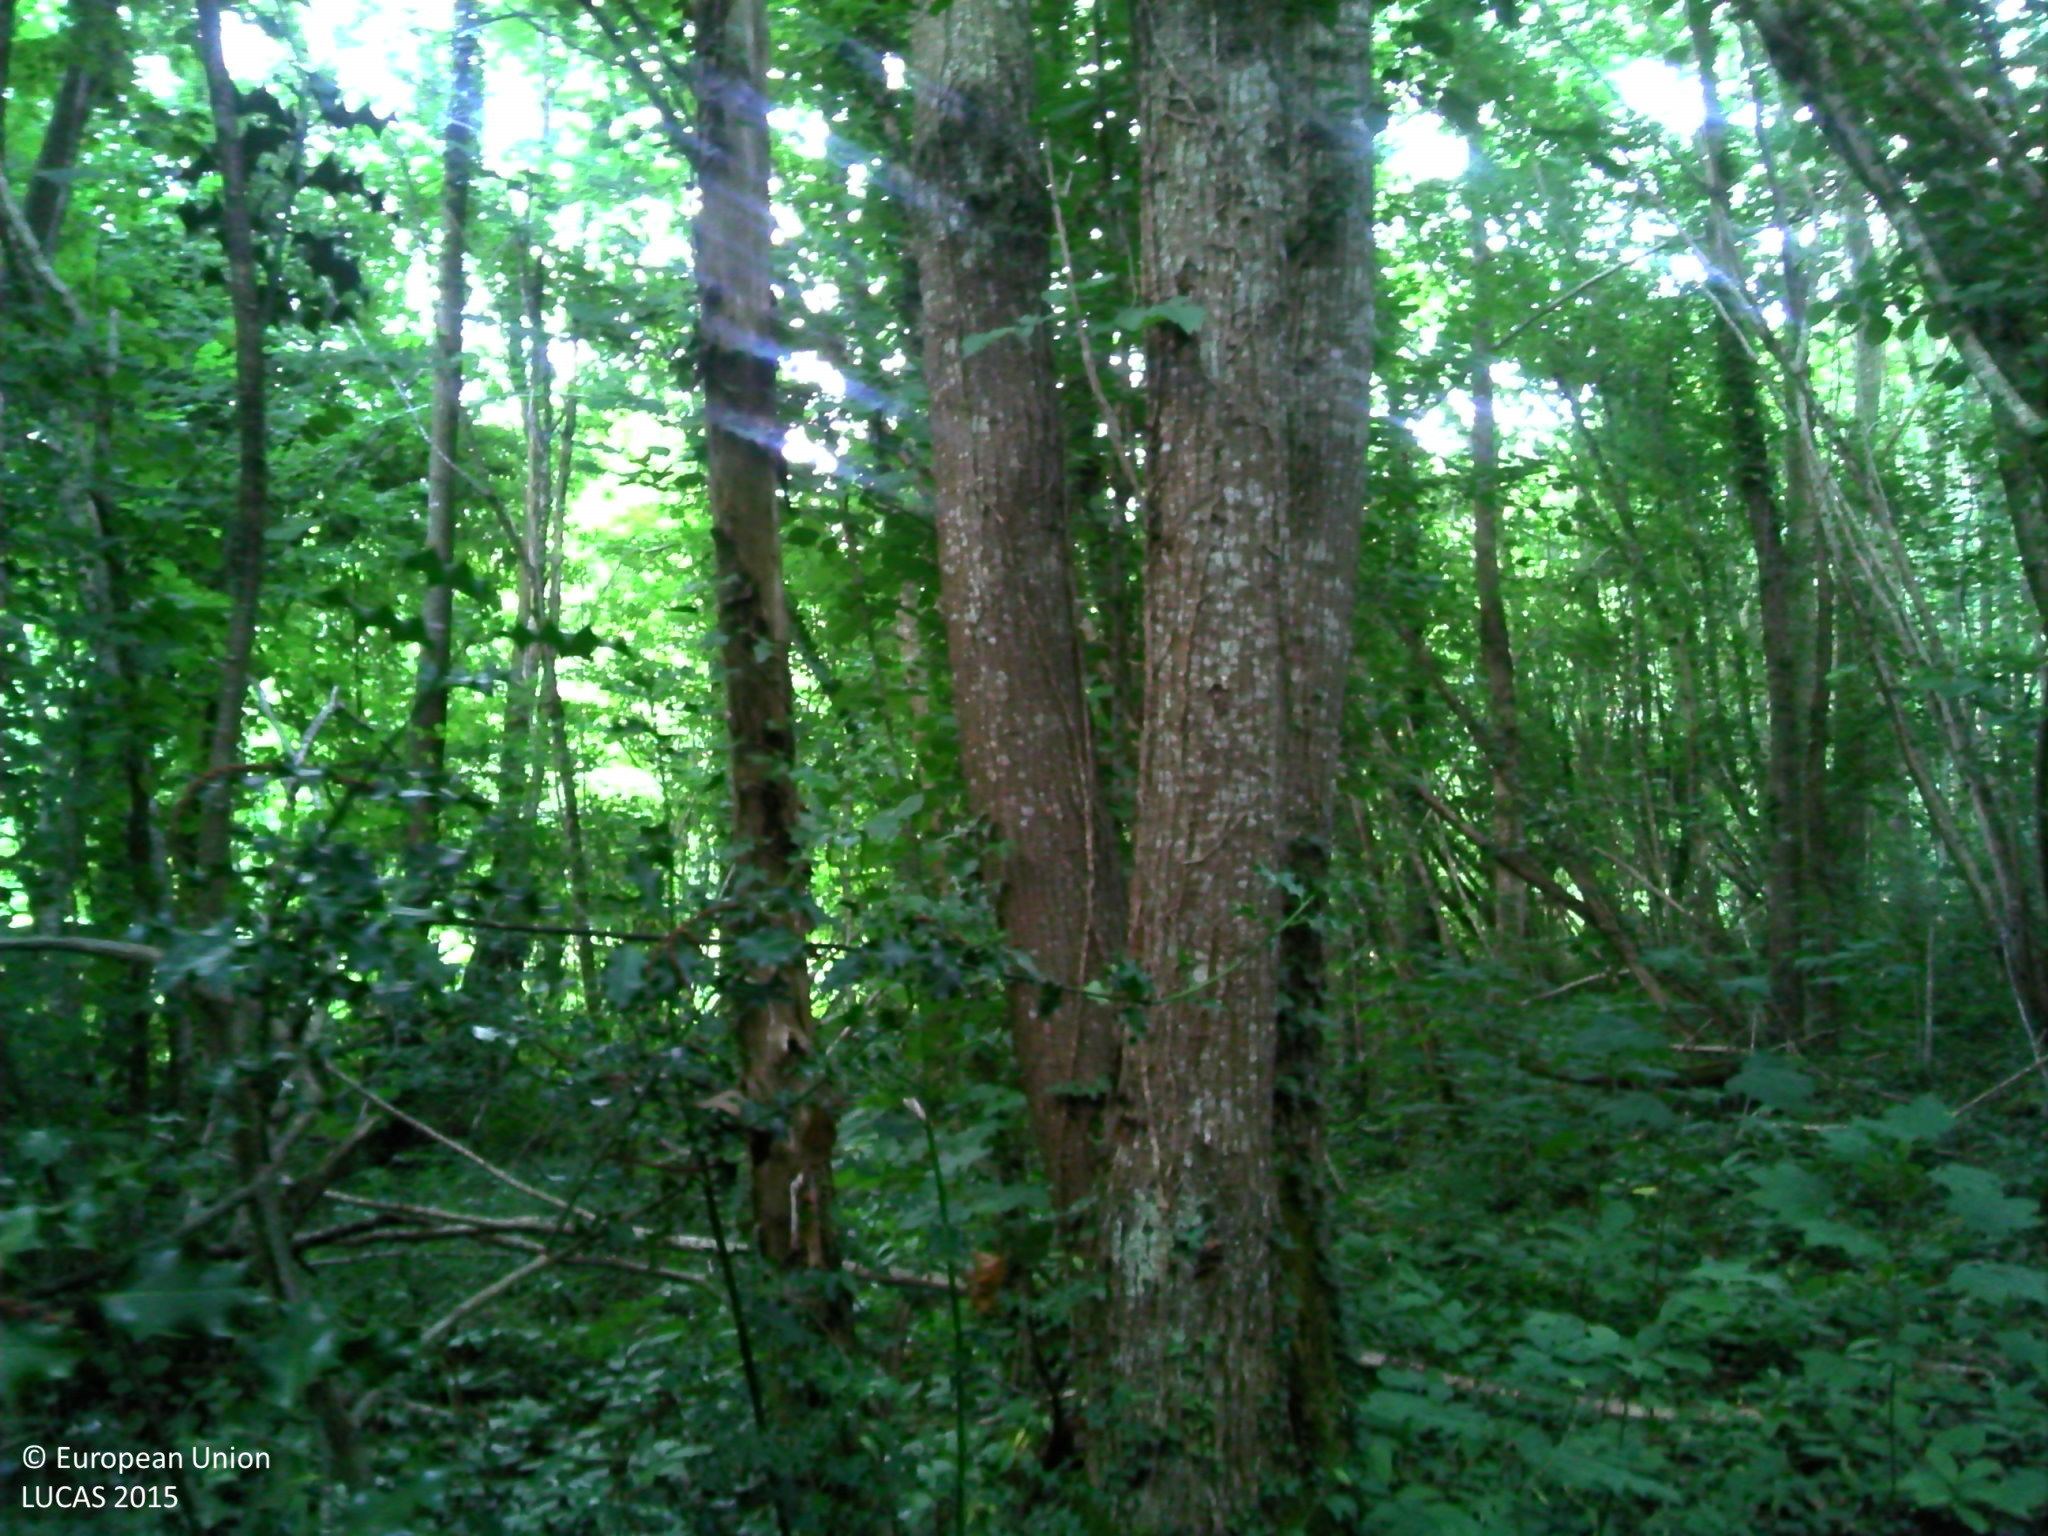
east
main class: Woodland
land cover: Broadleaved woodland
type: thermophilous deciduous forest
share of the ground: > 75 %
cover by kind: broadleaved forest trees 90 %, shrubs 5 %, herbaceous plants 5 %
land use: Forestry
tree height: > 5 m
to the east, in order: Broadleaved woodland; Grassland without tree/shrub cover; Tracks; Sunflower; Grass margins; Tracks; Broadleaved woodland; Spontaneously vegetated surfaces; Grassland without tree/shrub cover; Spontaneously vegetated surfaces; Broadleaved woodland; Tracks; Broadleaved woodland; Rivers and streams; Broadleaved woodland
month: August
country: FR
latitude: 43.3576
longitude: -1.0561
